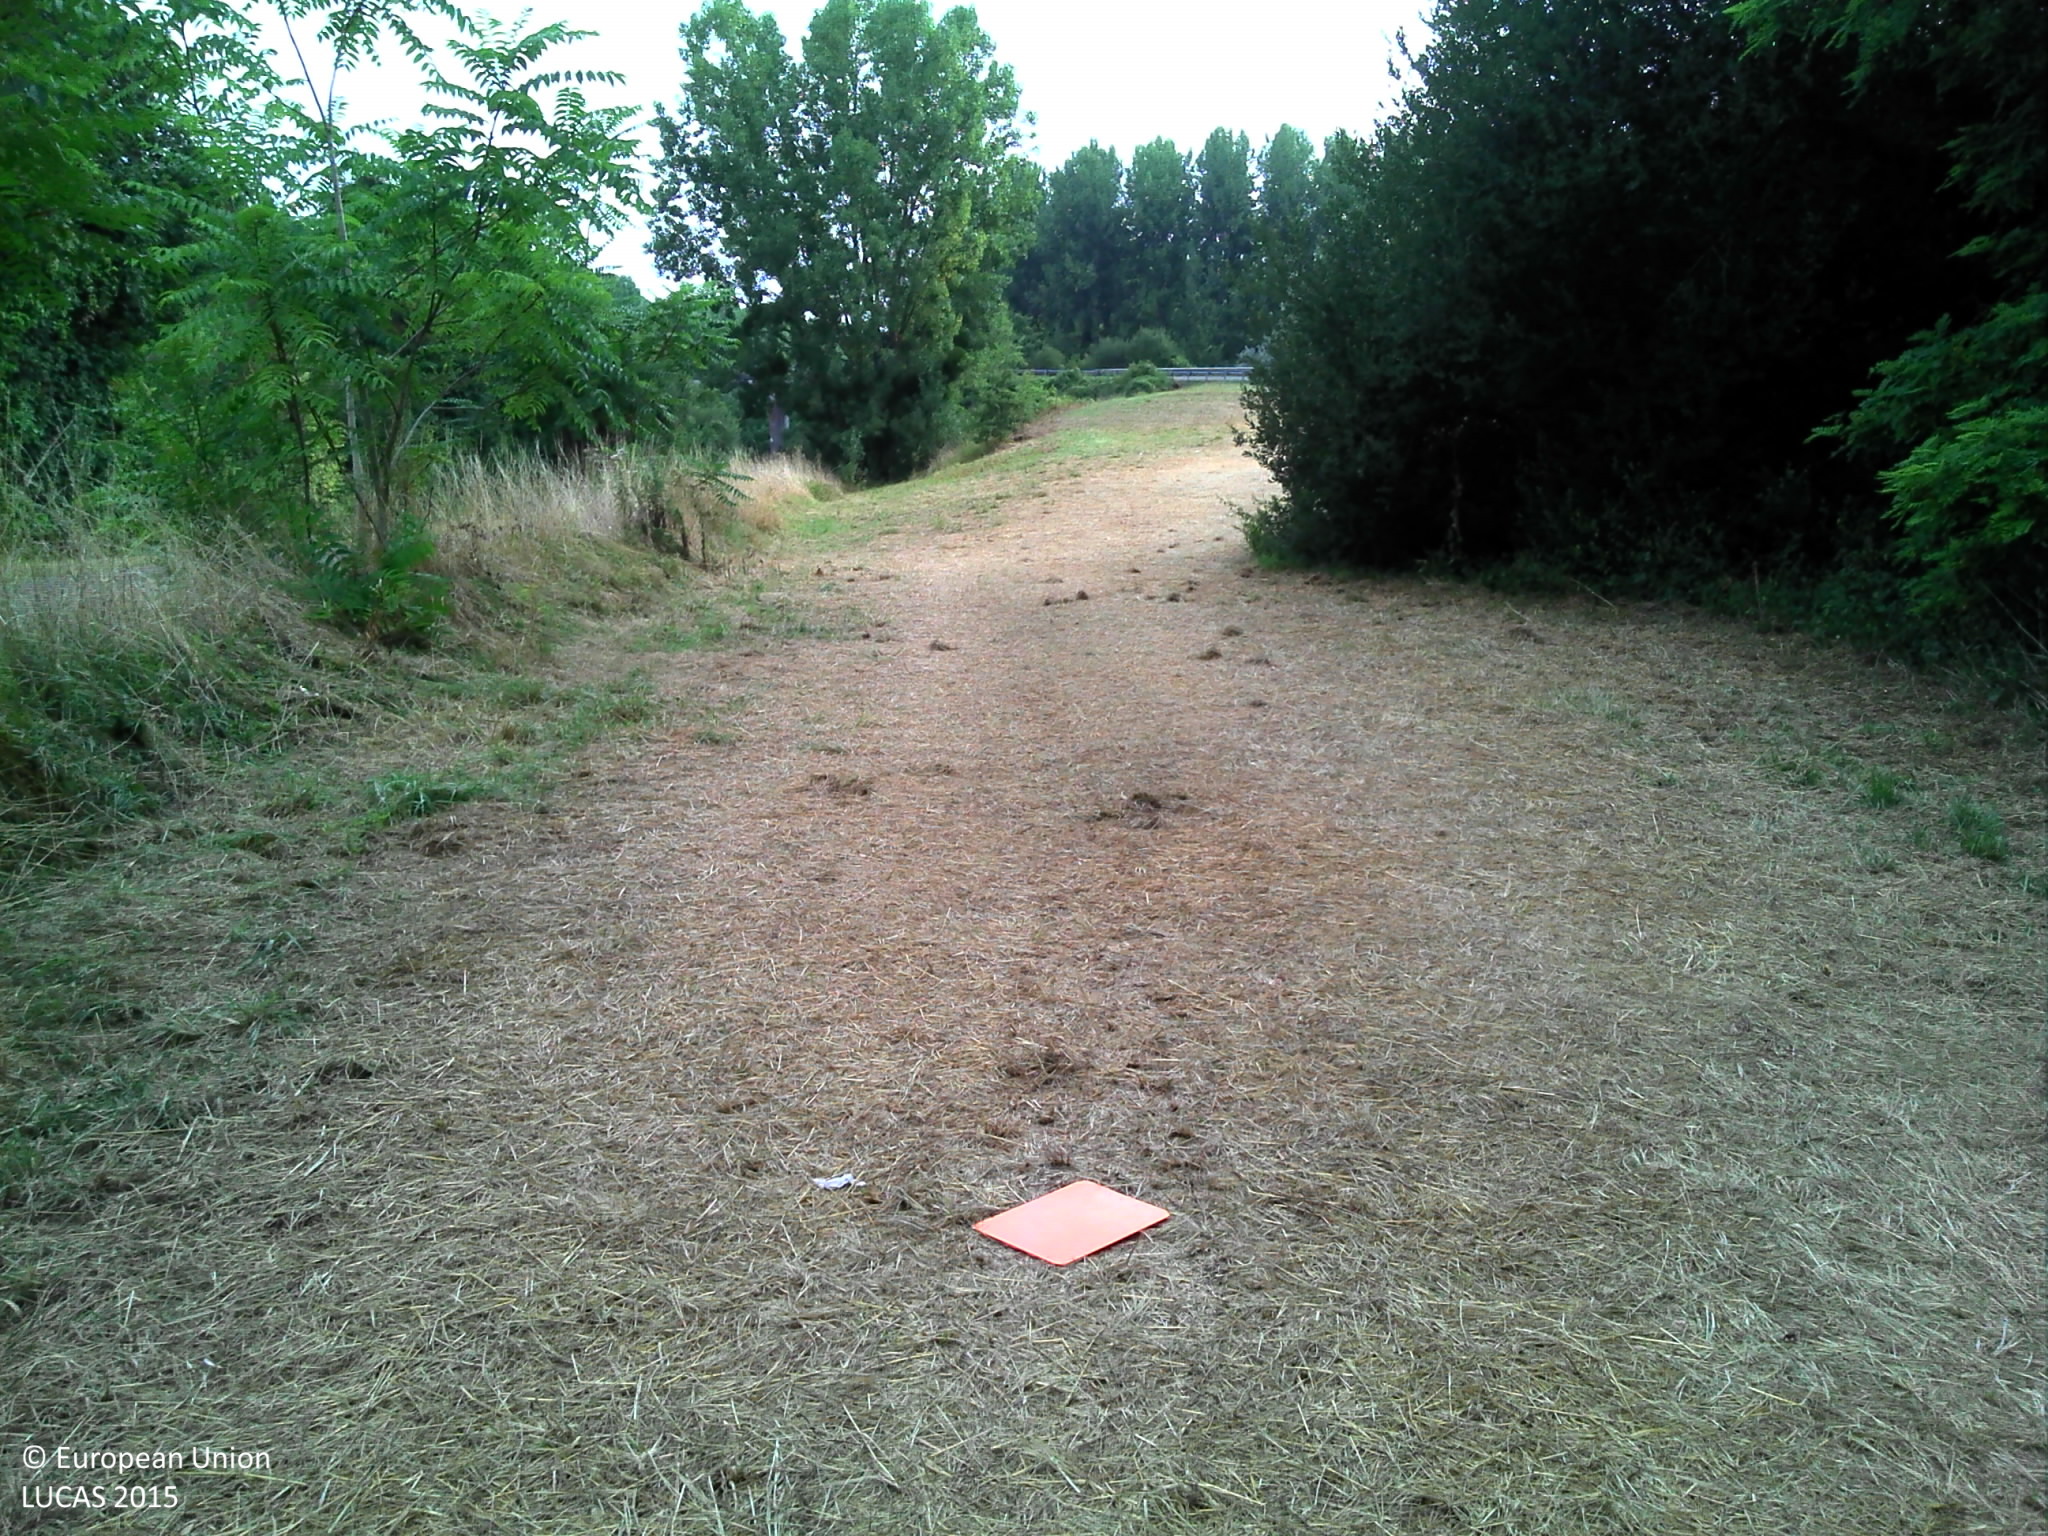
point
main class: Grassland
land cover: Grassland without tree/shrub cover
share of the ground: > 75 %
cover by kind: herbaceous plants 100 %
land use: Agriculture (excluding fallow land and kitchen gardens)
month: August
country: FR
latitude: 46.4720
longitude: 0.3046
